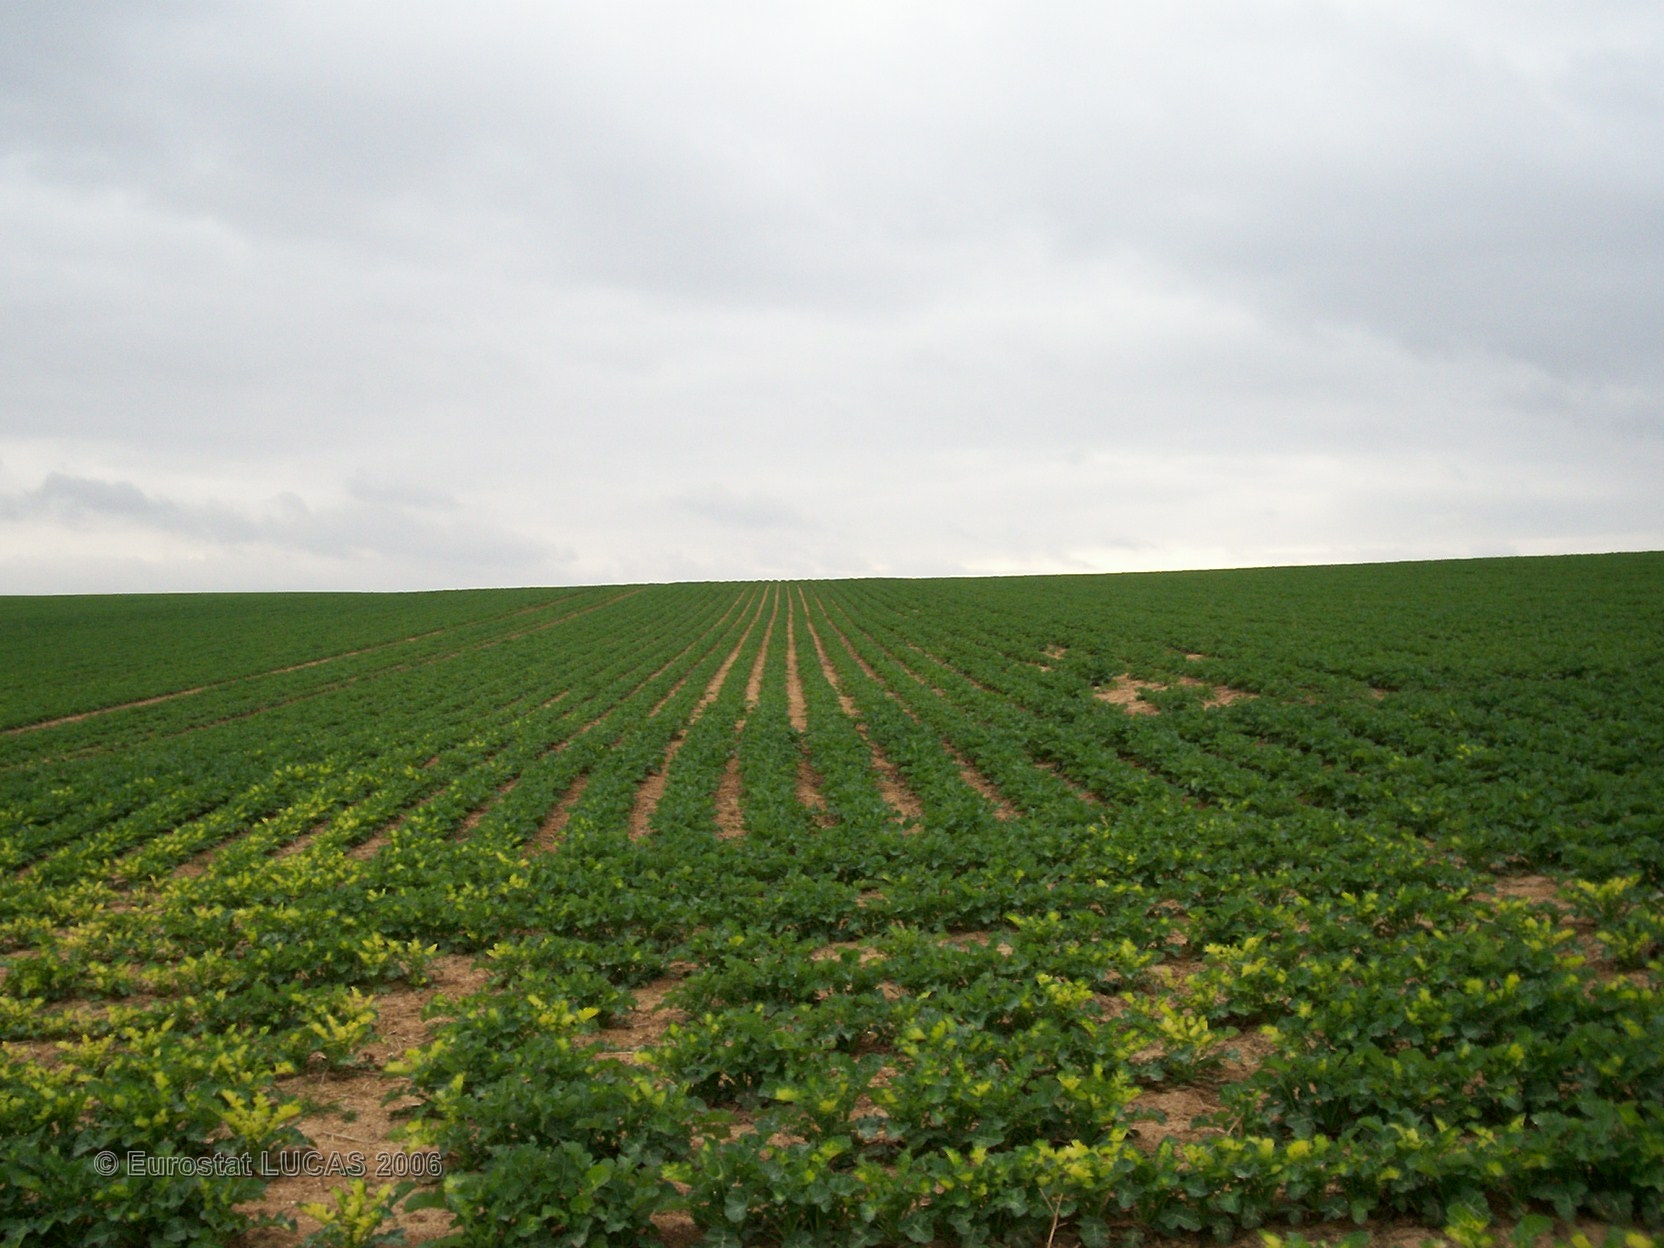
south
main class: Cropland
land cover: Rape and turnip rape
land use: Agriculture (excluding fallow land and kitchen gardens)
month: April
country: FR
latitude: 49.2205
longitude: 4.4633
